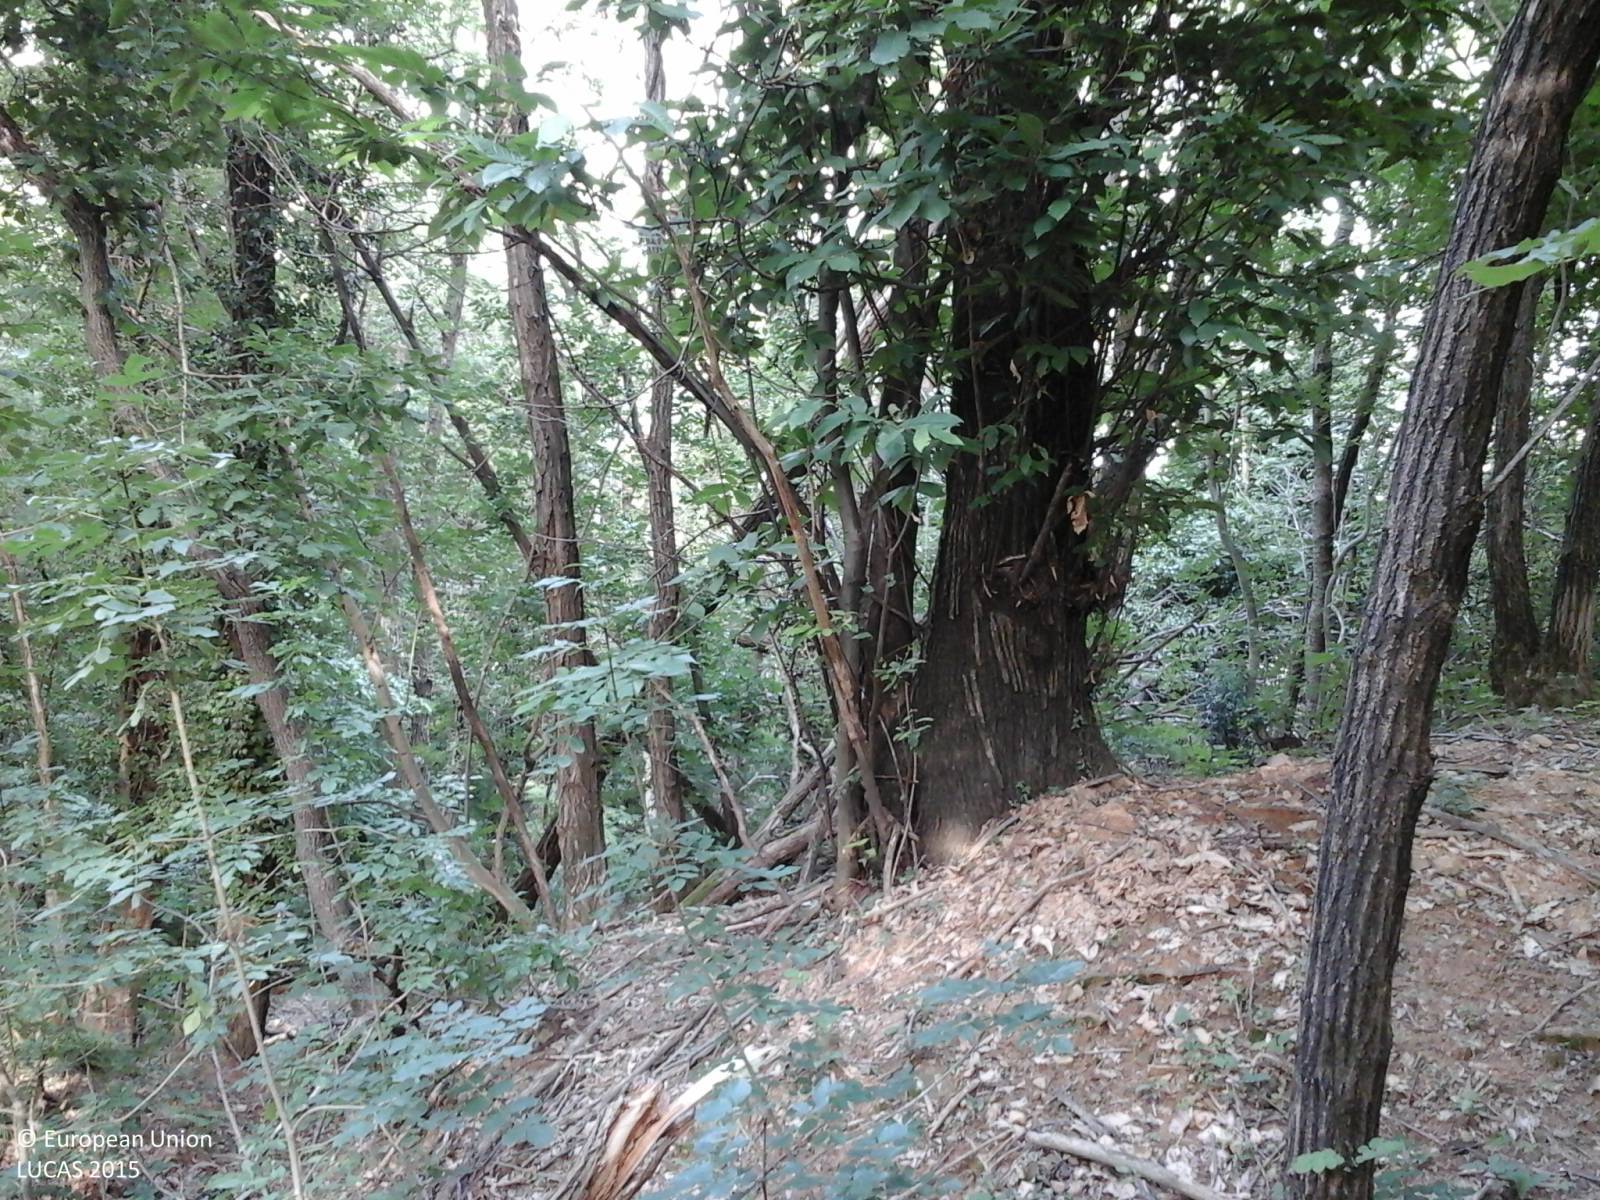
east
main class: Woodland
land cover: Broadleaved woodland
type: thermophilous deciduous forest
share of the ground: > 75 %
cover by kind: broadleaved forest trees 90 %, shrubs 10 %
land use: Forestry
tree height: > 5 m
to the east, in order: Broadleaved woodland
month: June
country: IT
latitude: 45.9482
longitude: 13.5953
